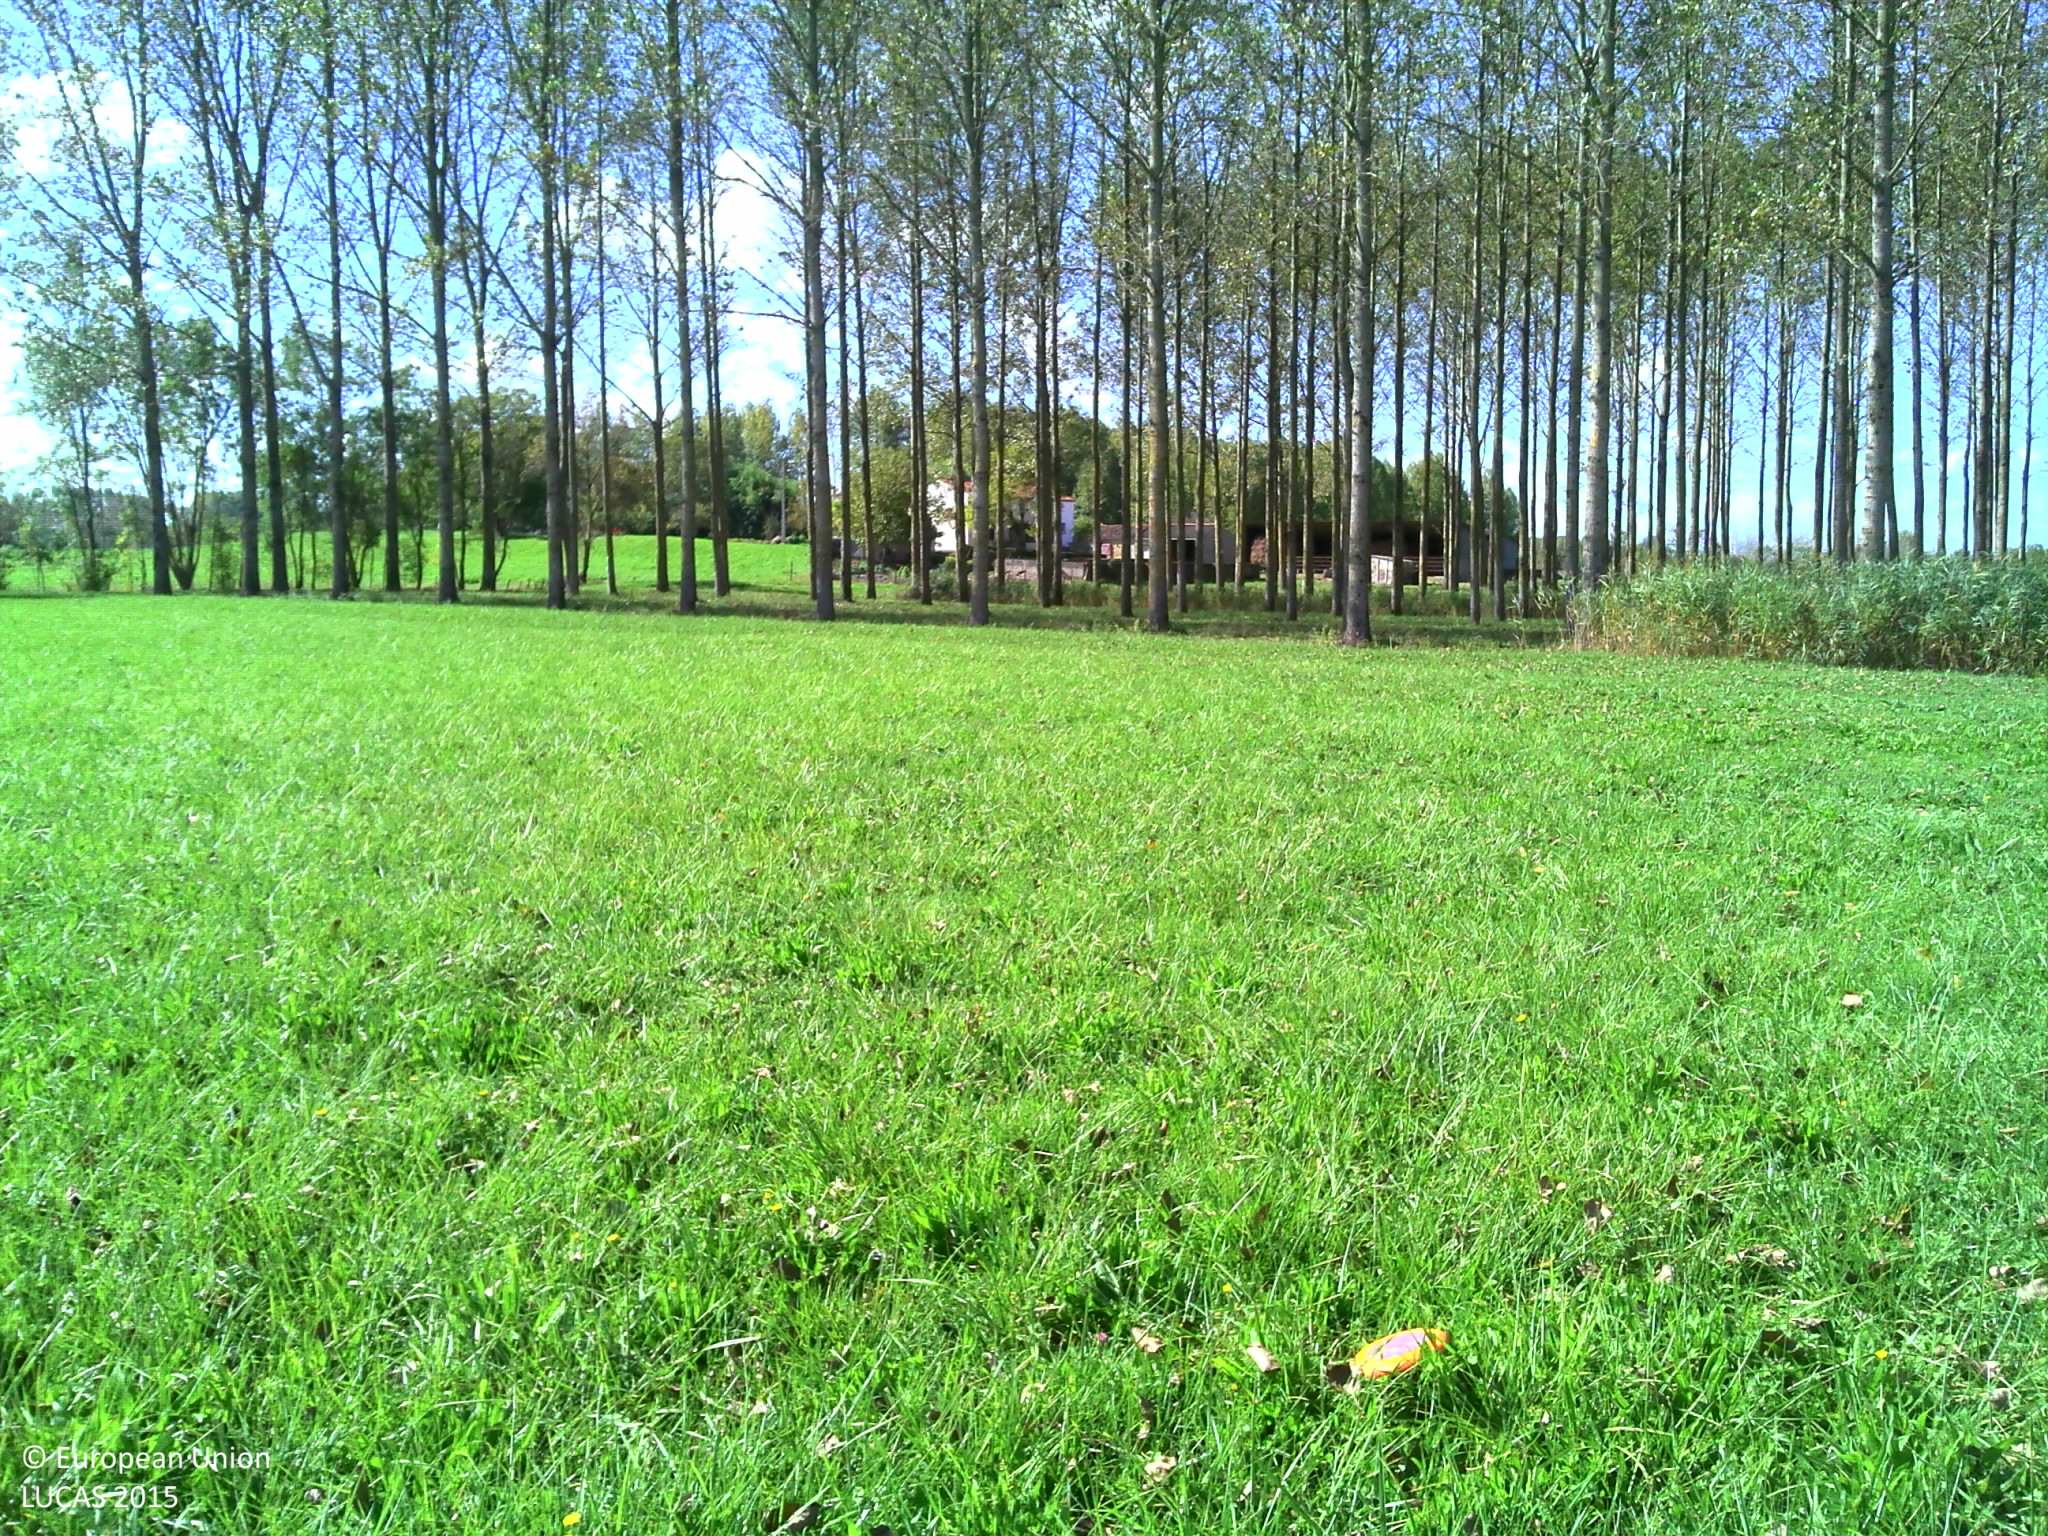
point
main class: Grassland
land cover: Grassland without tree/shrub cover
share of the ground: > 75 %
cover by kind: herbaceous plants 100 %
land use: Agriculture (excluding fallow land and kitchen gardens)
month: October
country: FR
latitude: 46.3475
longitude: -0.8010
